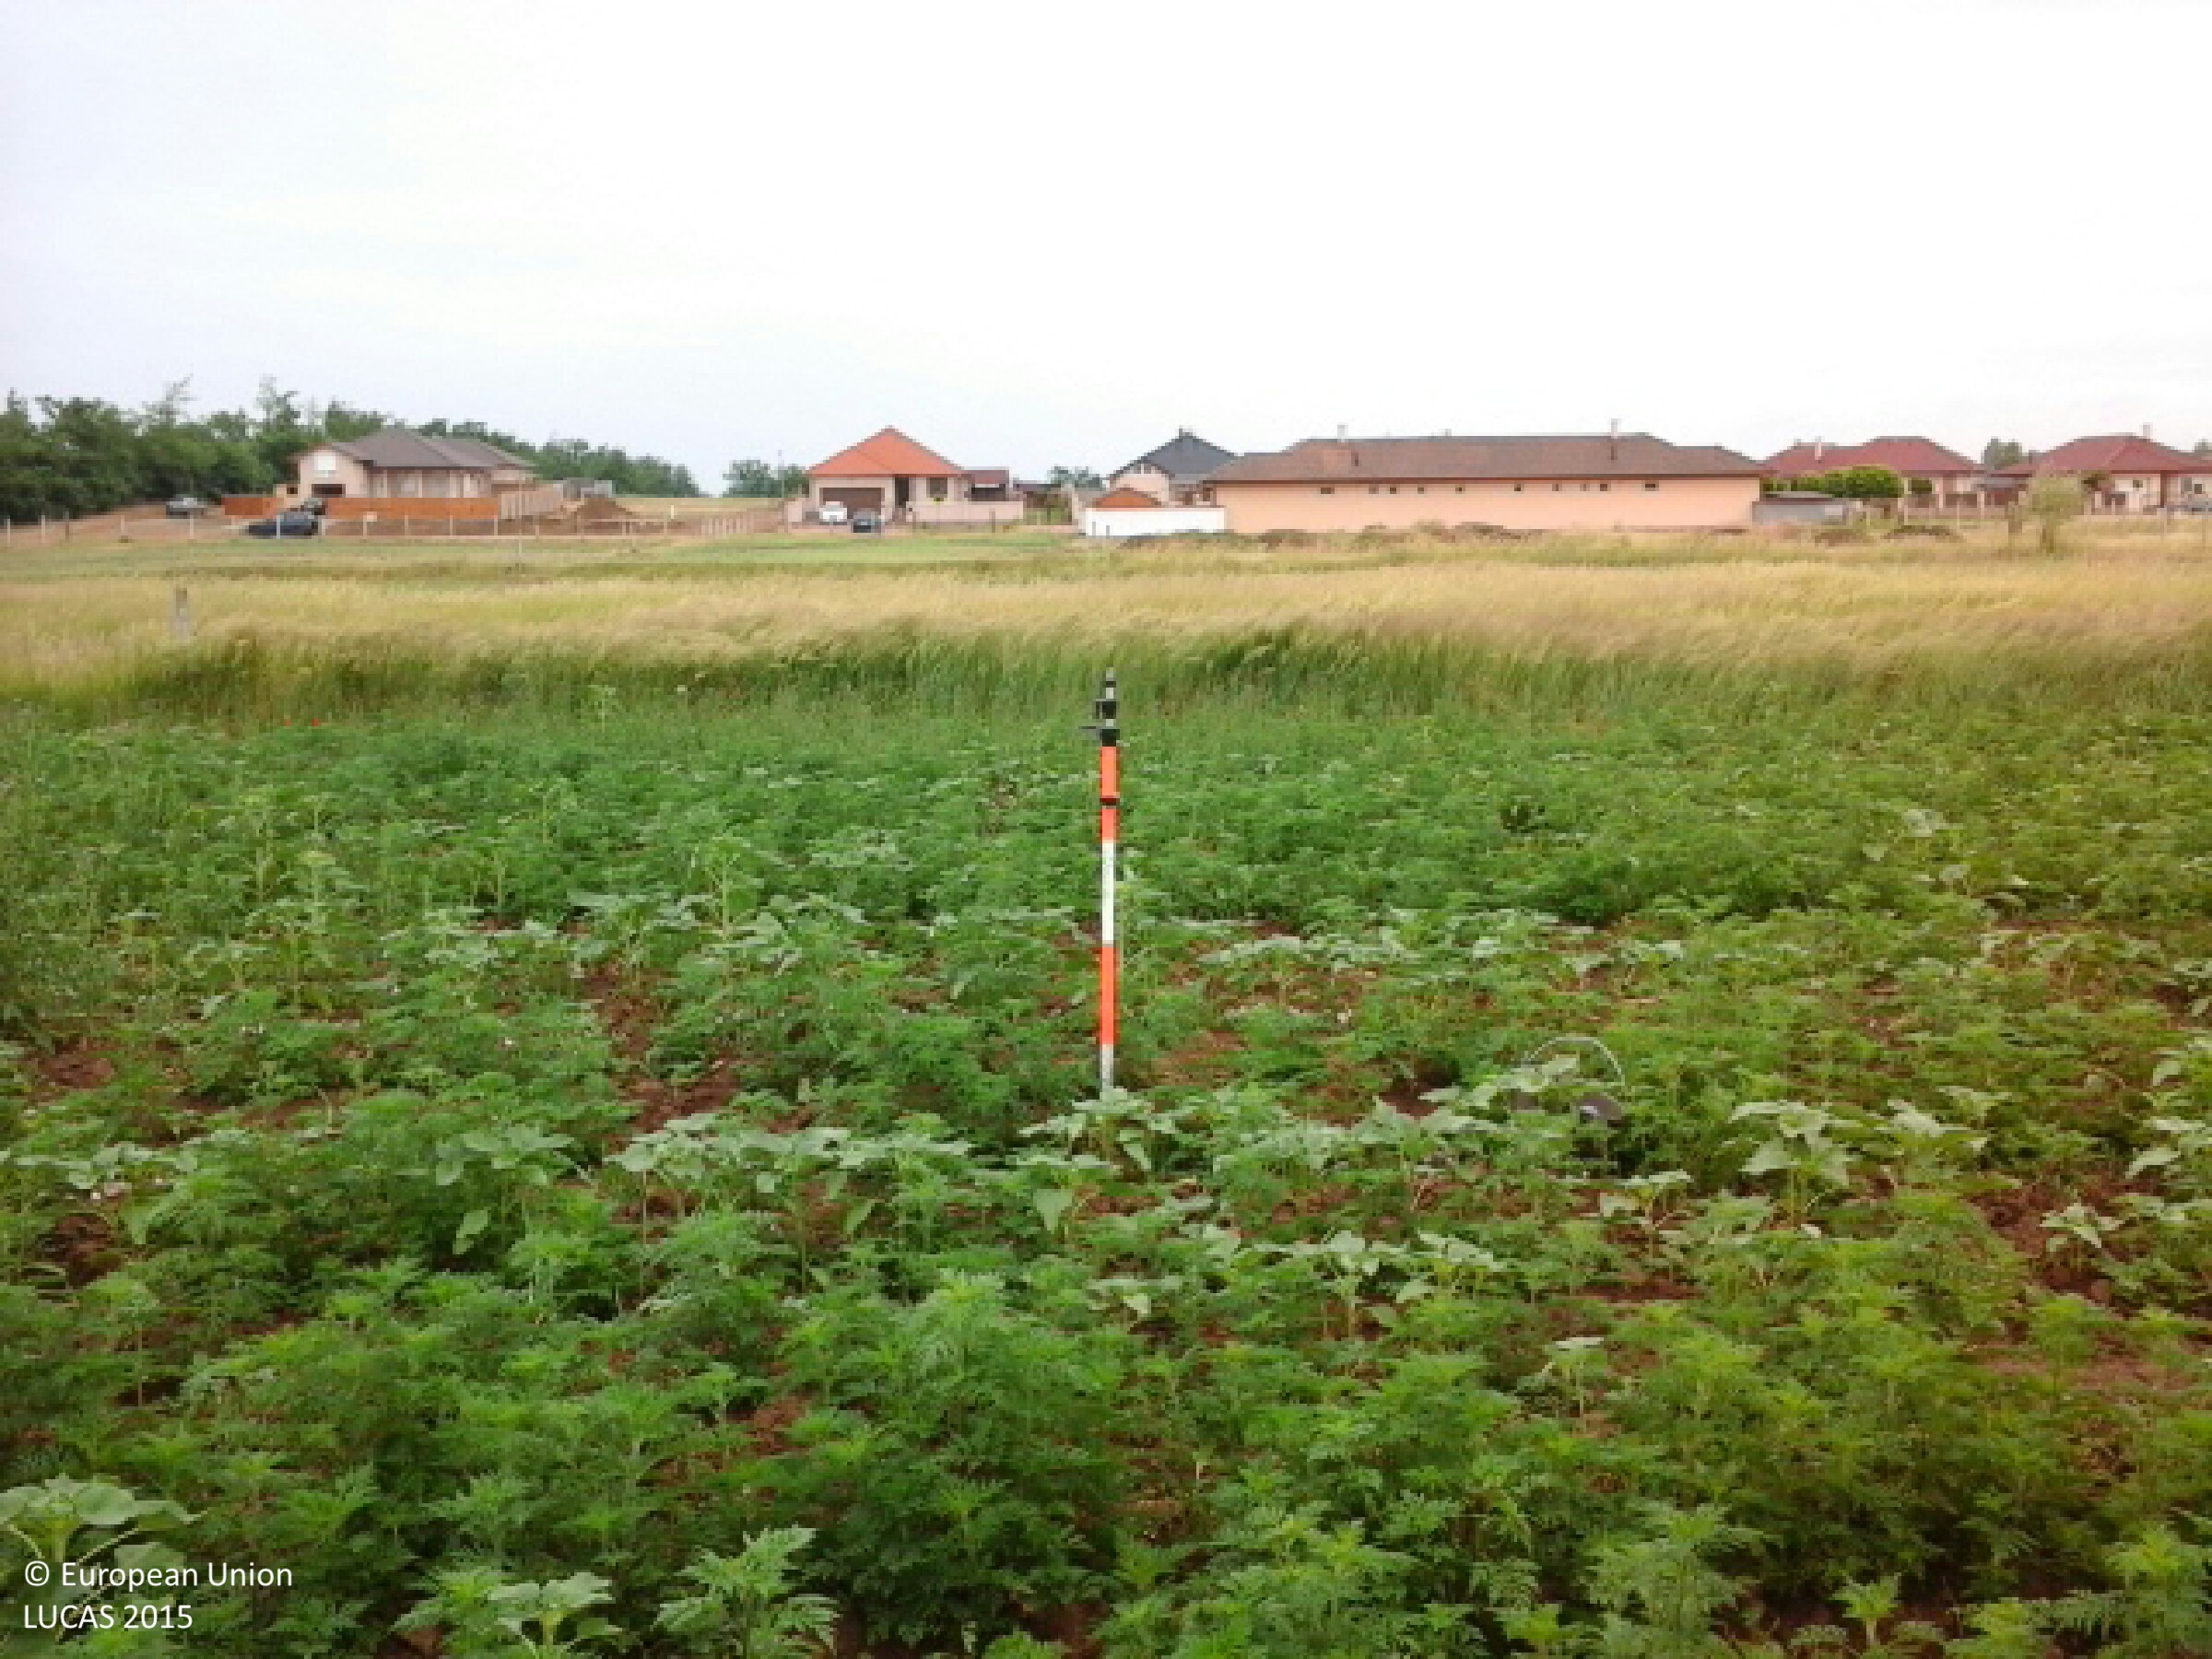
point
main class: Cropland
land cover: Sunflower
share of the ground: 10 - 25 %
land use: Agriculture (excluding fallow land and kitchen gardens)
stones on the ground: < 10 %
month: June
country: HU
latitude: 47.9547
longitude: 21.7655
